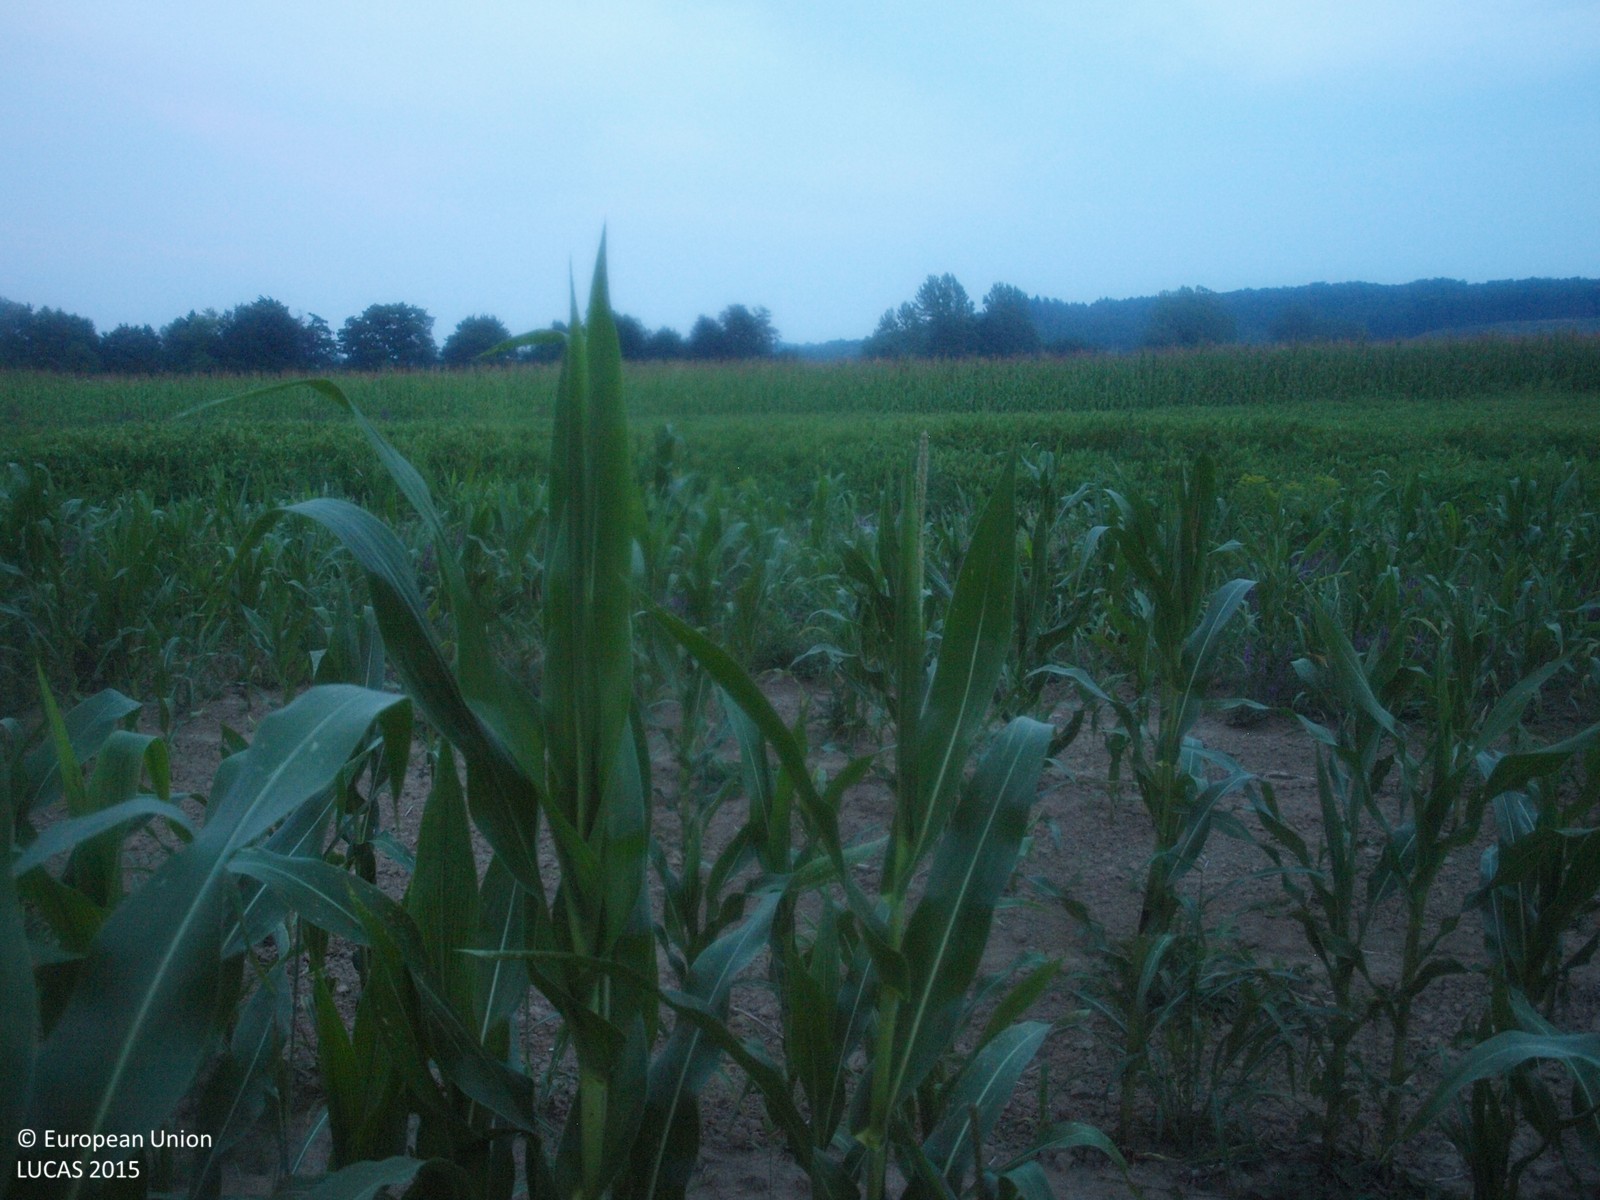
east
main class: Cropland
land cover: Maize
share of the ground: > 75 %
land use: Agriculture (excluding fallow land and kitchen gardens)
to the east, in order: Maize; Cherry fruit; Maize; Ditches and canals; Paved roads, cycling and walking lanes; Ditches and canals; Maize; Grassland without tree/shrub cover; Rivers and streams; Maize
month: July
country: HR
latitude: 46.2407
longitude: 16.5498
